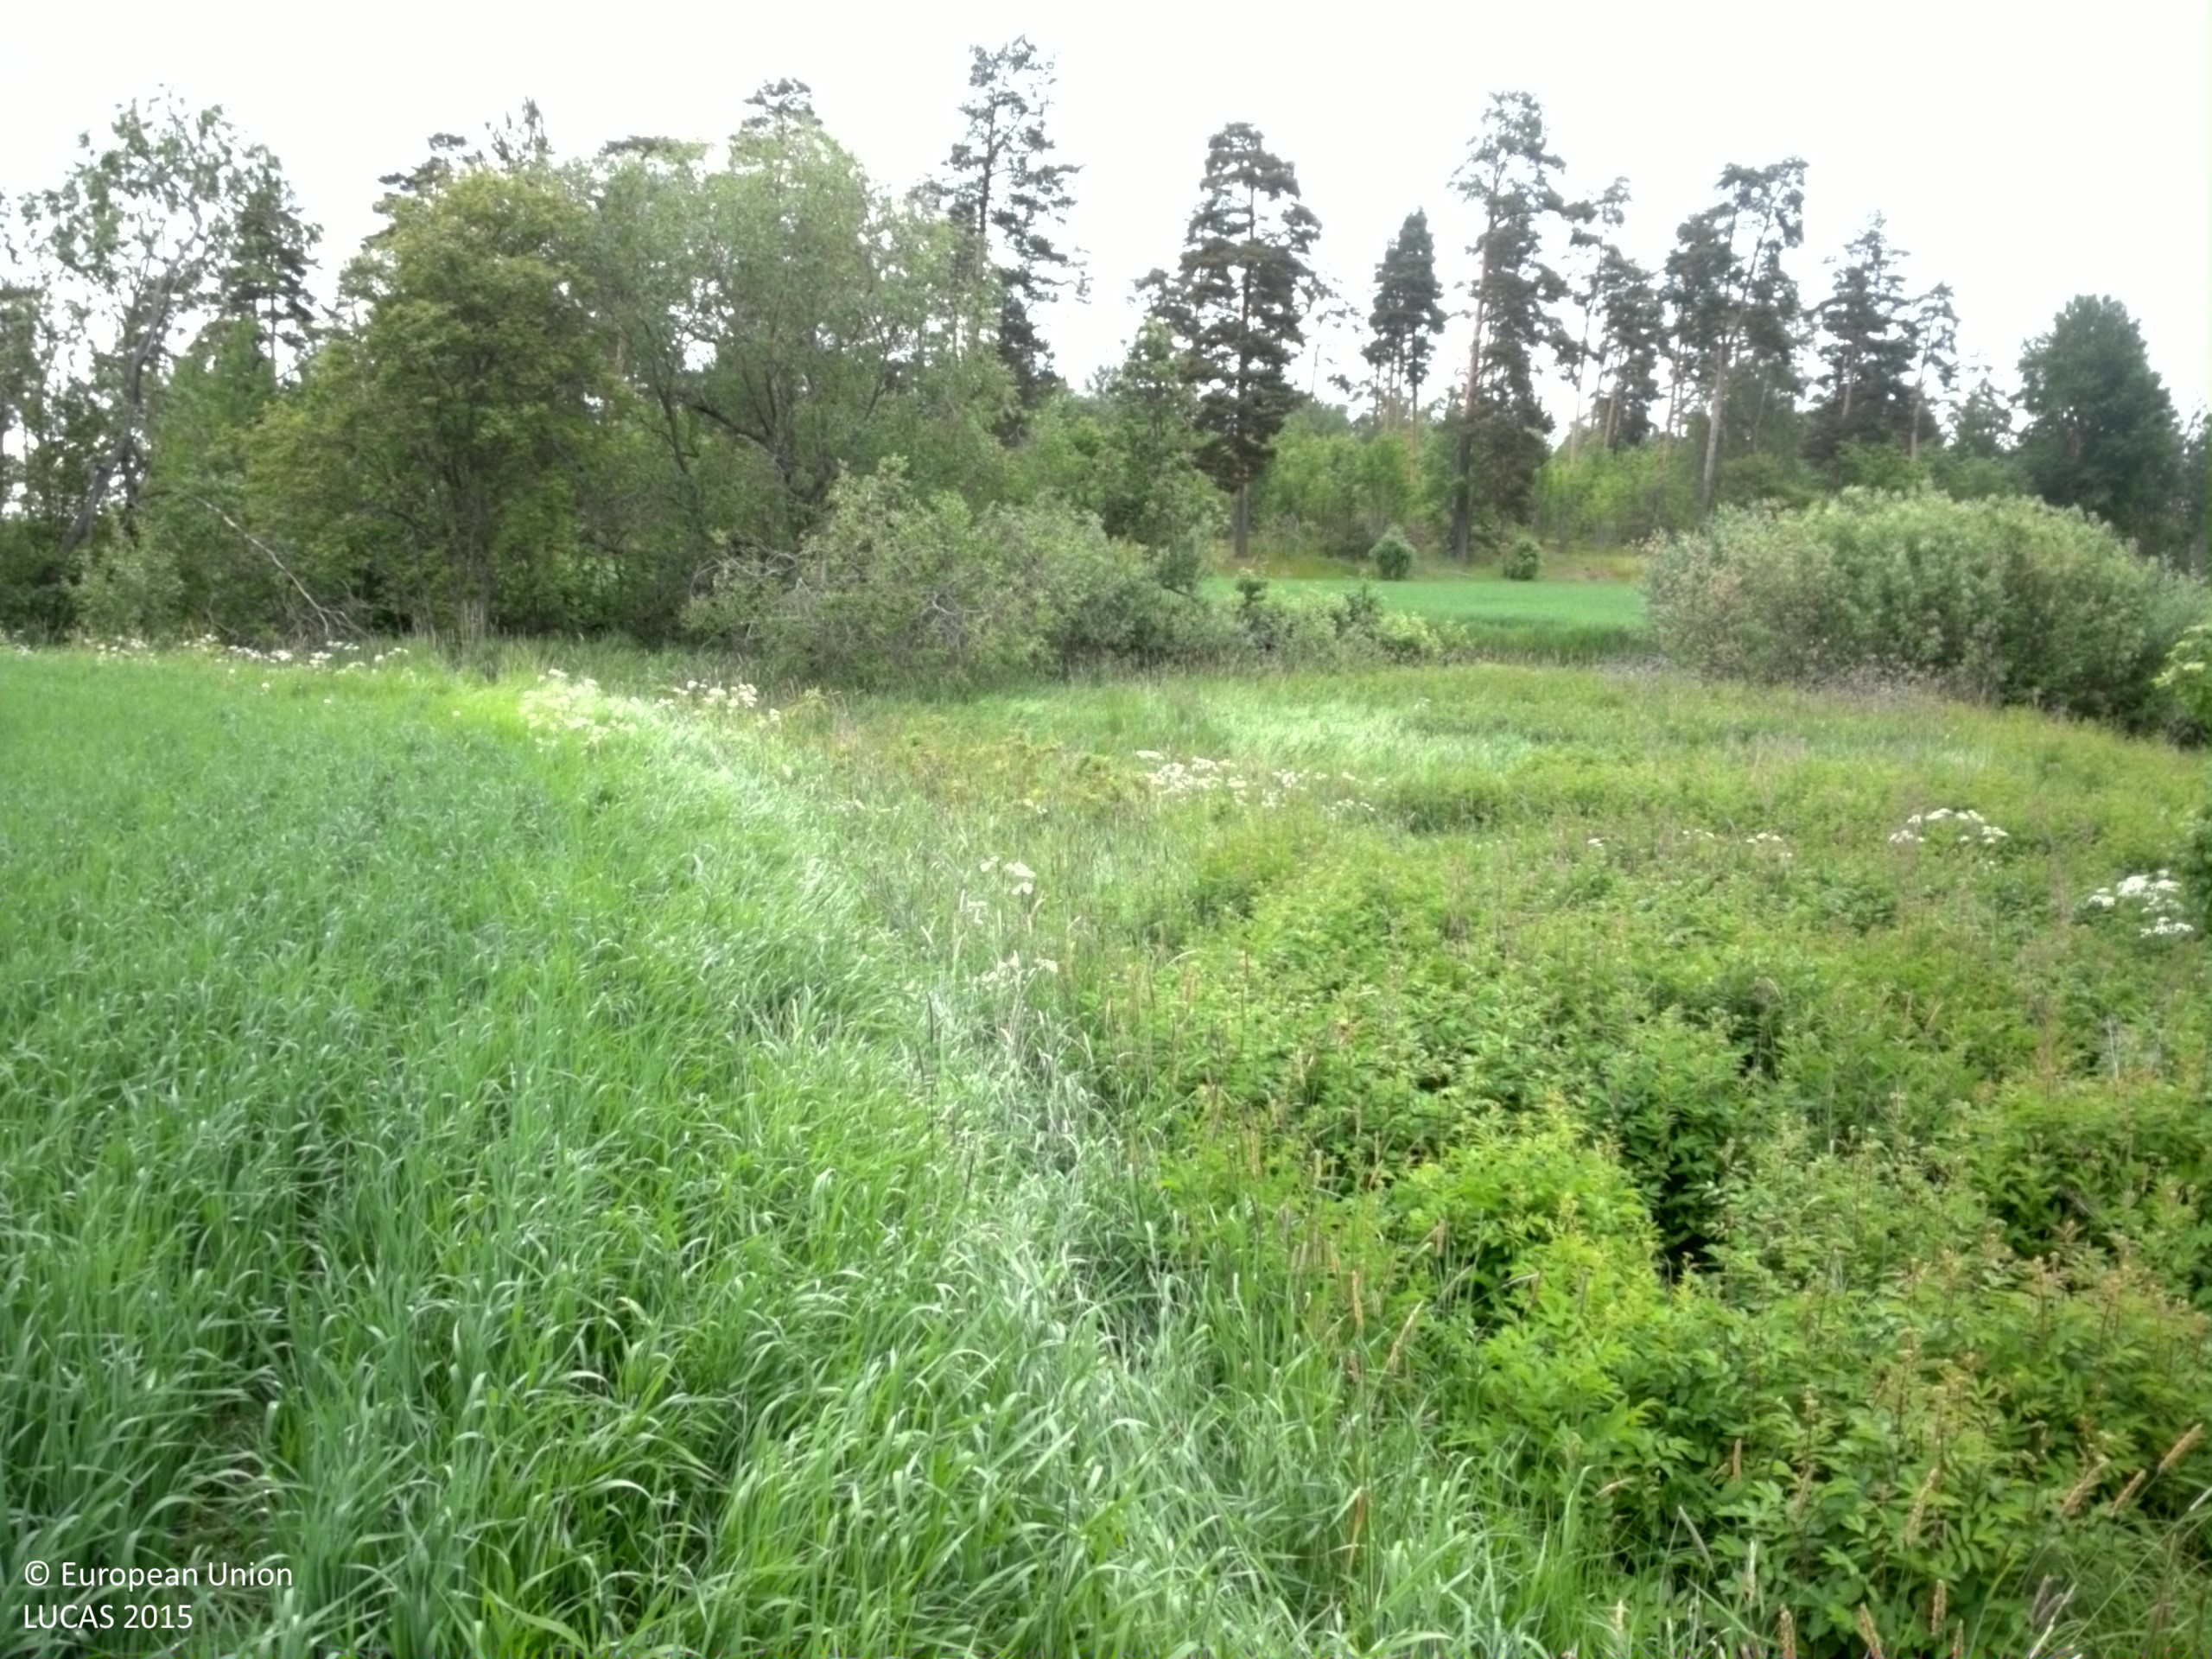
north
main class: Cropland
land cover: Oats
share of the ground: > 75 %
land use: Agriculture (excluding fallow land and kitchen gardens)
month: June
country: SE
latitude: 60.1737
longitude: 17.6173
